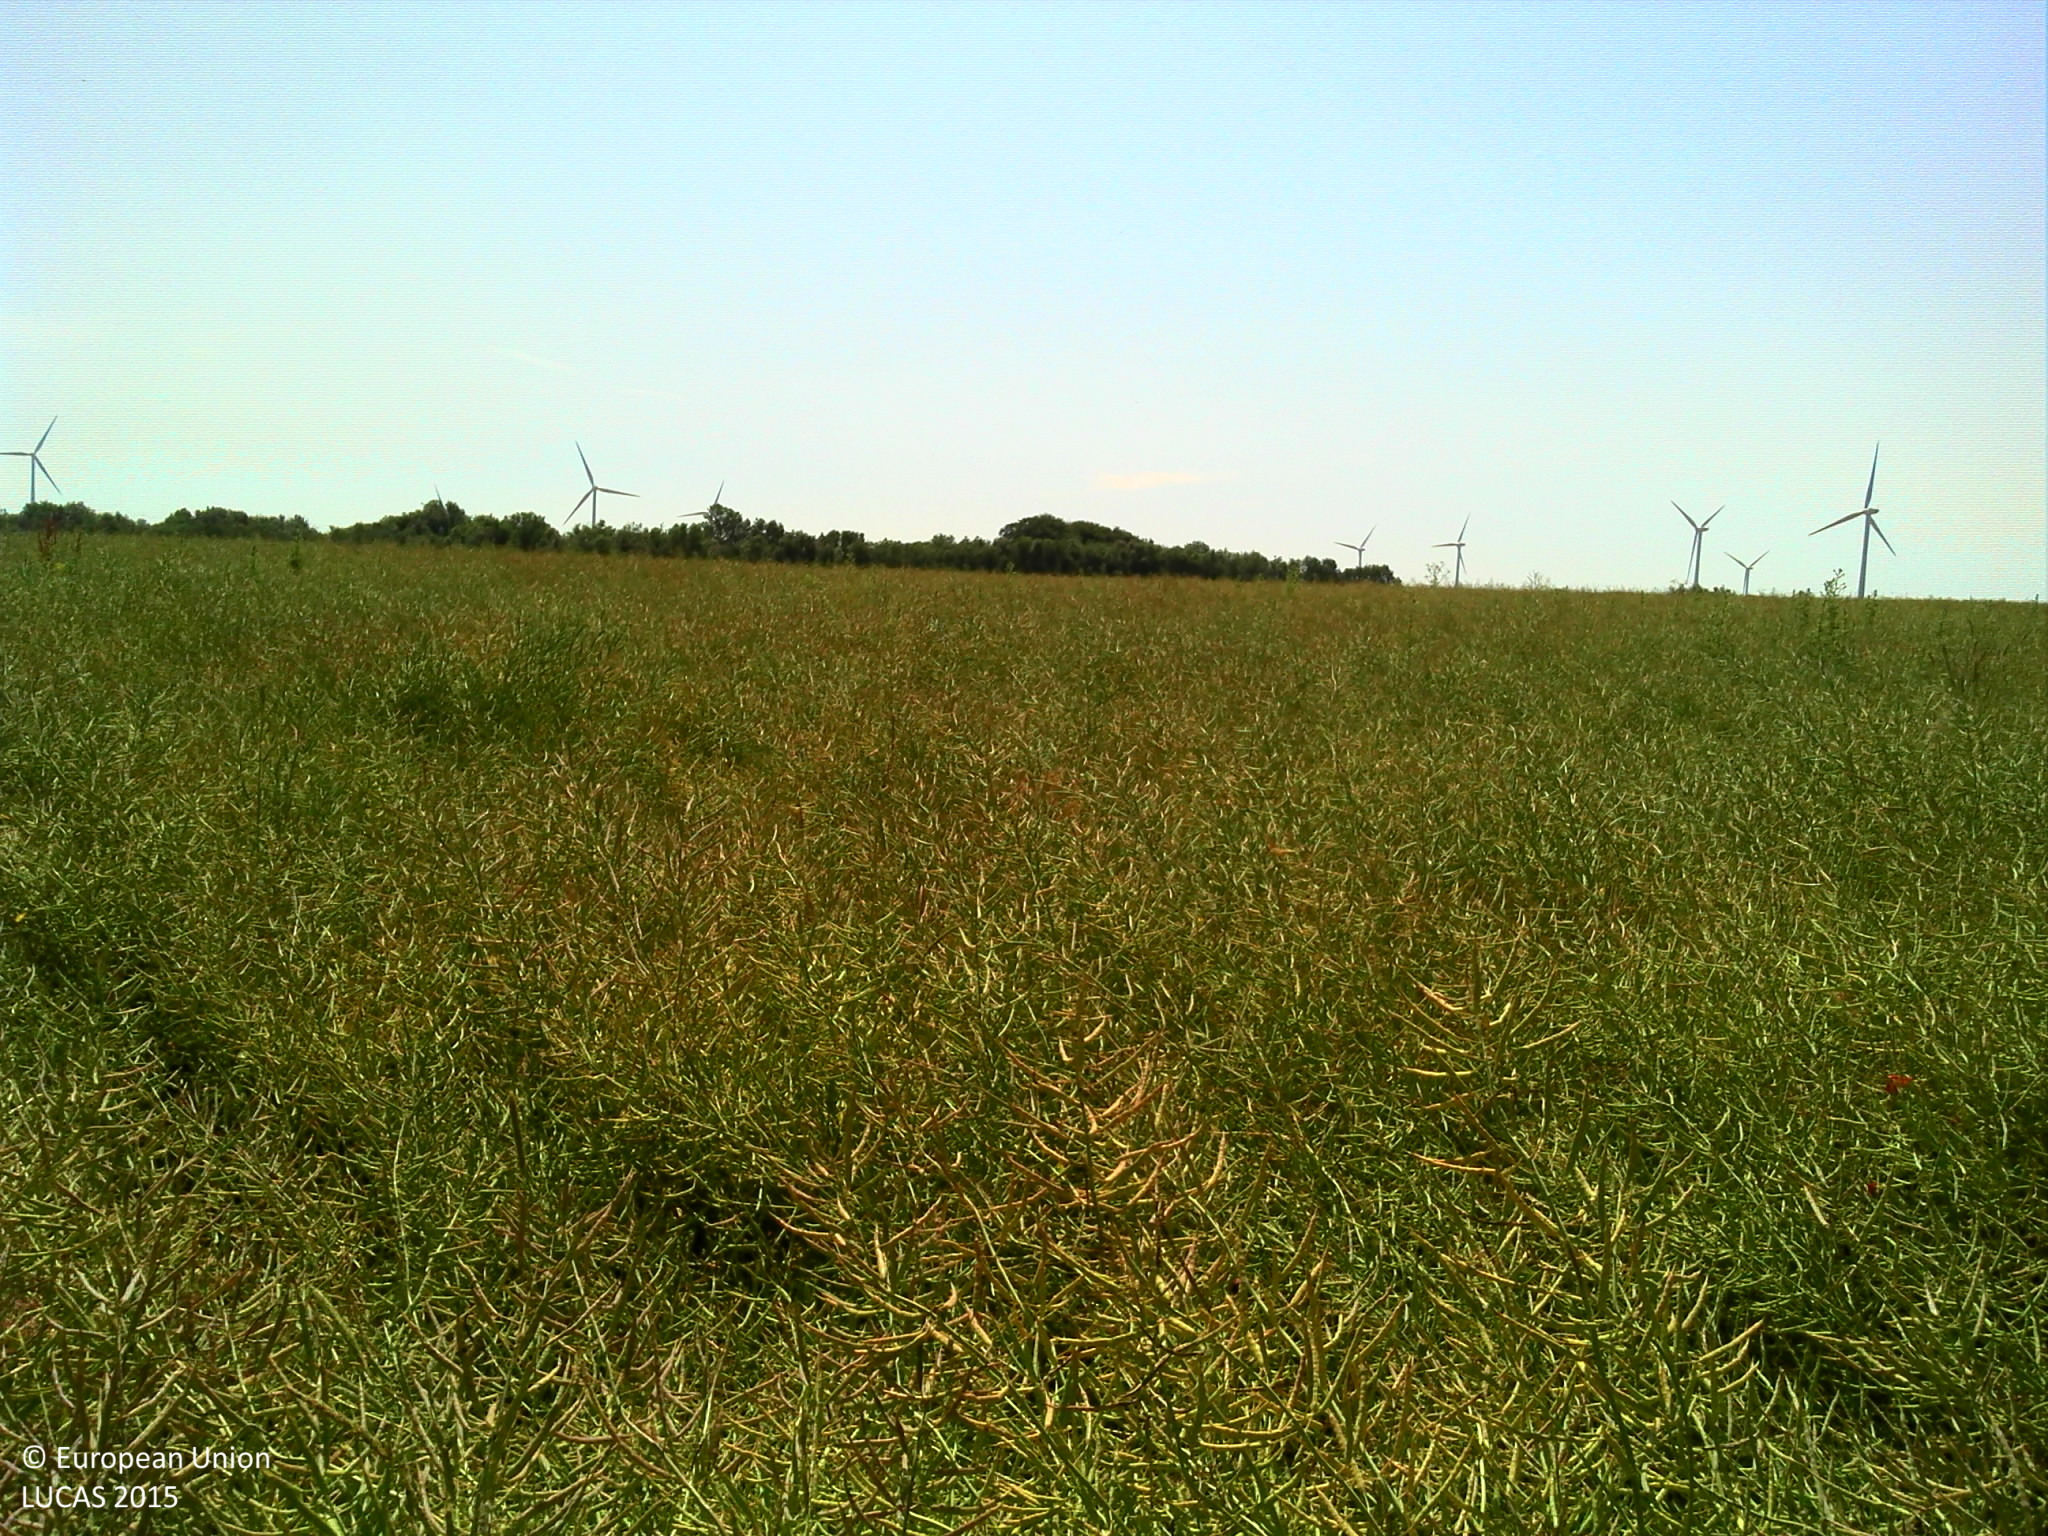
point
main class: Cropland
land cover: Rape and turnip rape
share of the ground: > 75 %
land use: Agriculture (excluding fallow land and kitchen gardens)
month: July
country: FR
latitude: 50.2517
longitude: 2.3431
